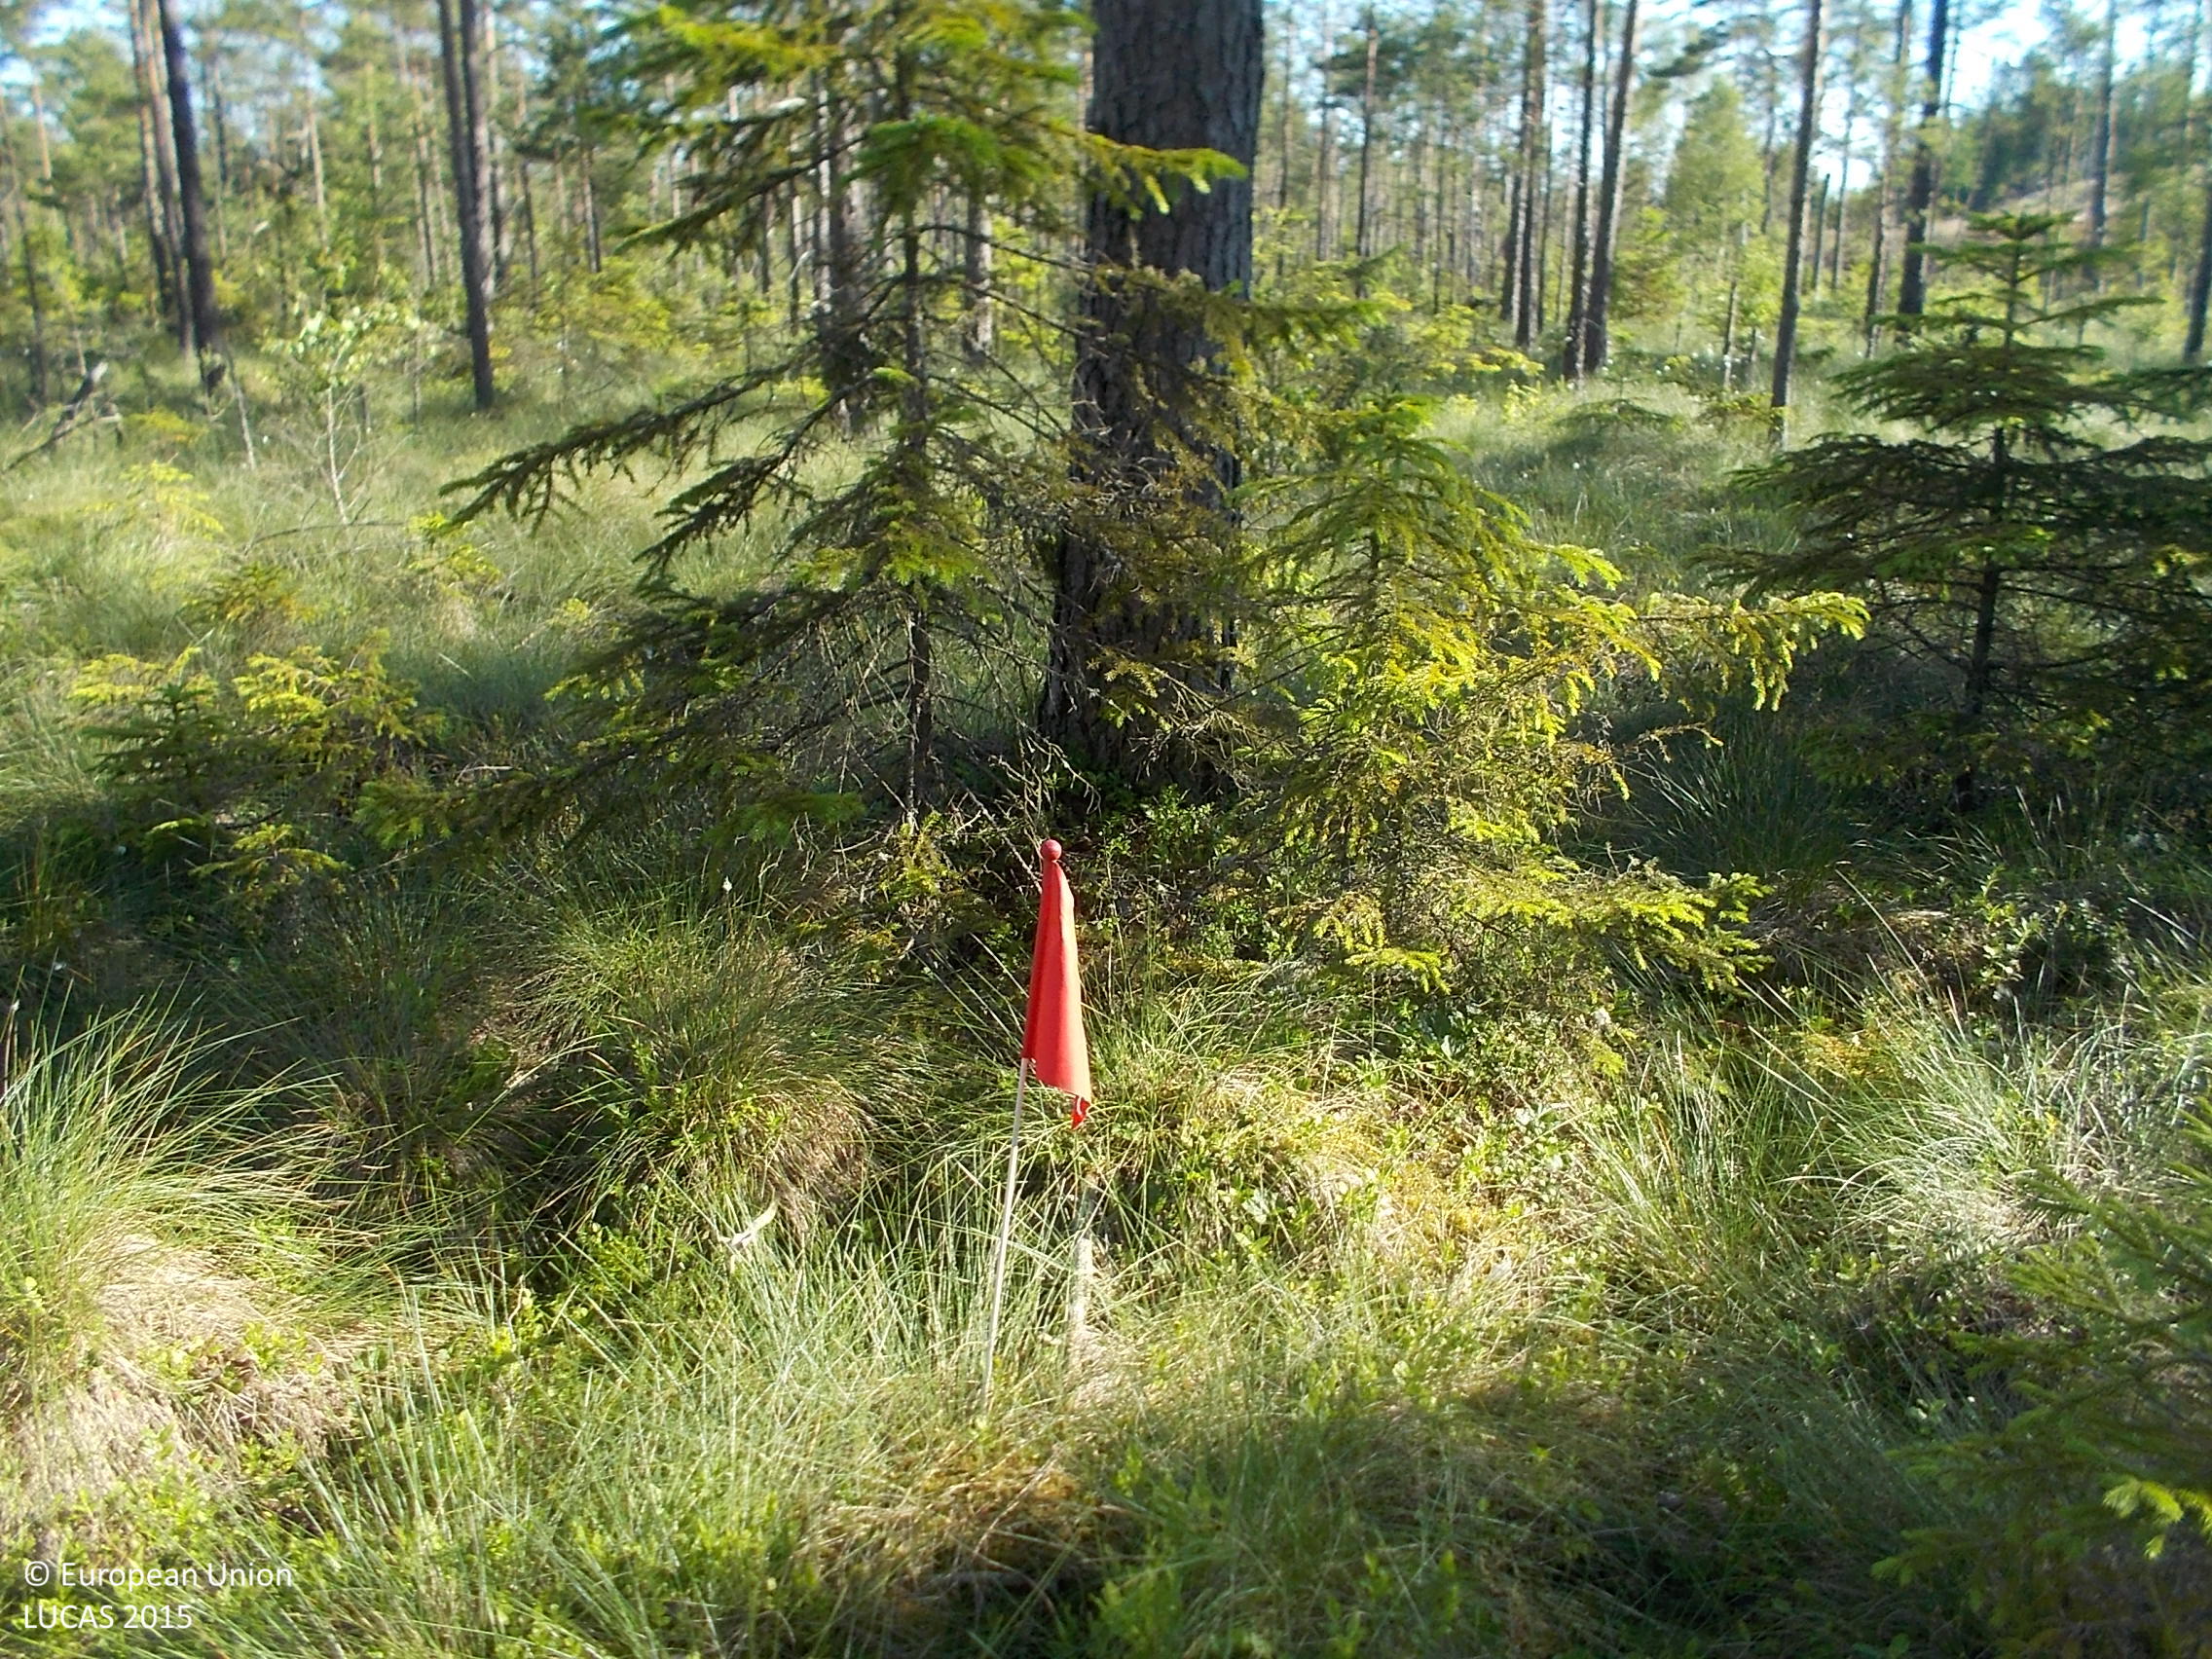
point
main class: Woodland
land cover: Pine dominated coniferous woodland
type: boreal forest
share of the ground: 50 - 75 %
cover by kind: coniferous forest trees 60 %, herbaceous plants 35 %, lichens and mosses 5 %
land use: Forestry
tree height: > 5 m
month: July
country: SE
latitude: 57.2465
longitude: 13.1614
